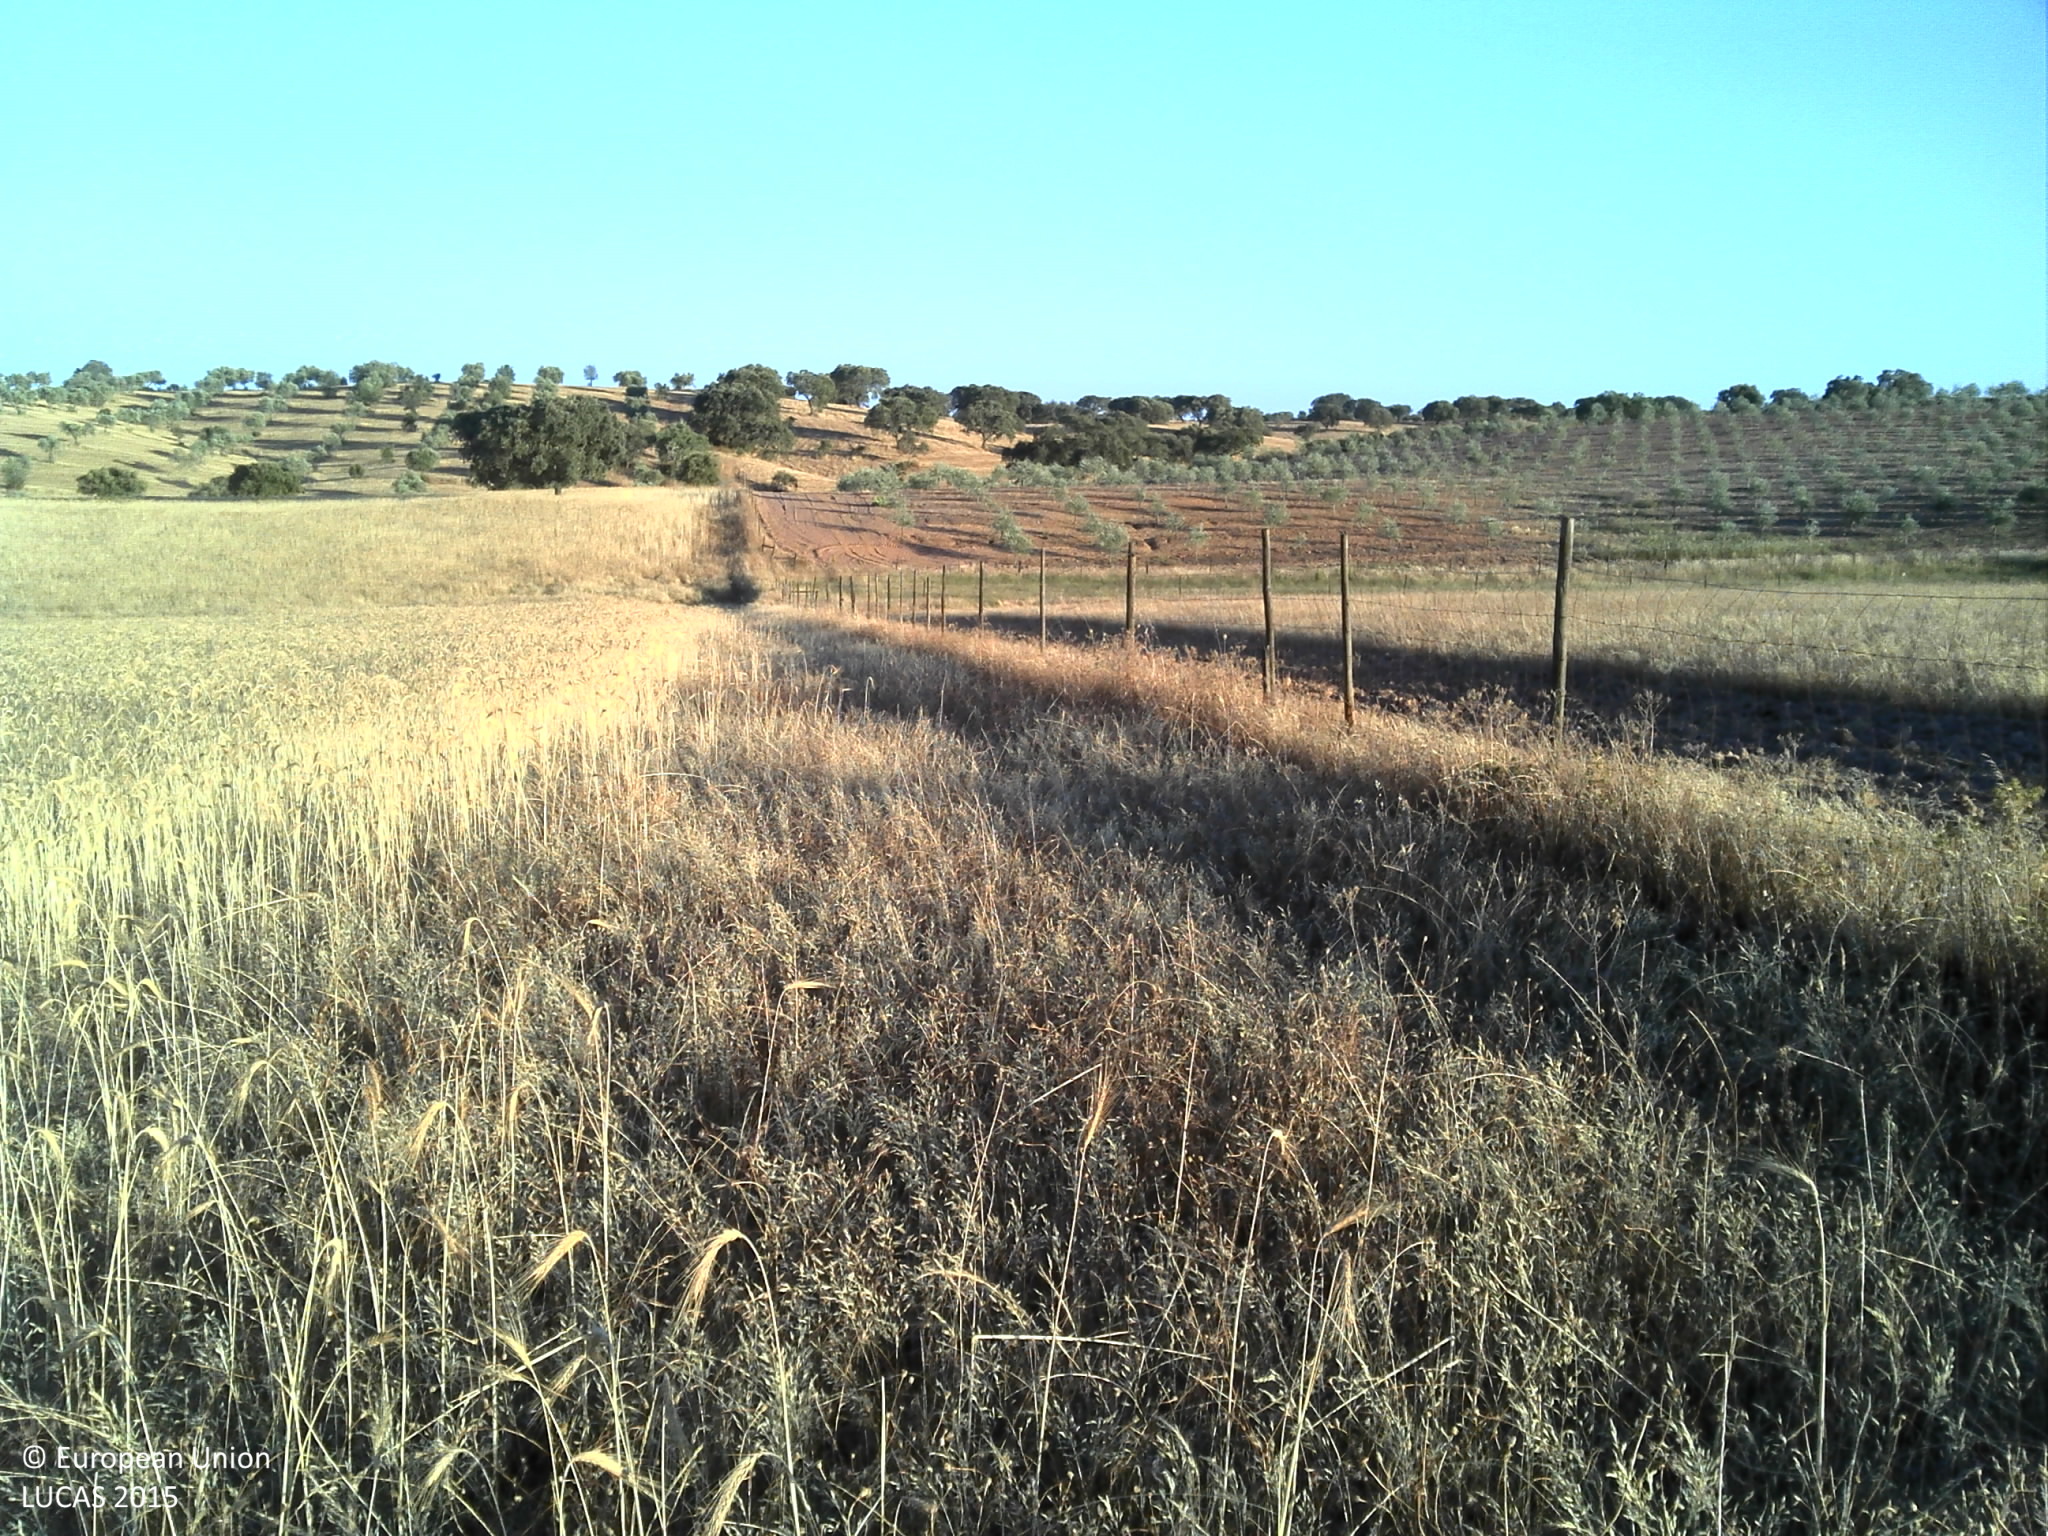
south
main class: Cropland
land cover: Common wheat
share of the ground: > 75 %
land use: Agriculture (excluding fallow land and kitchen gardens)
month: June
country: PT
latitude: 37.8986
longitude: -7.3335
